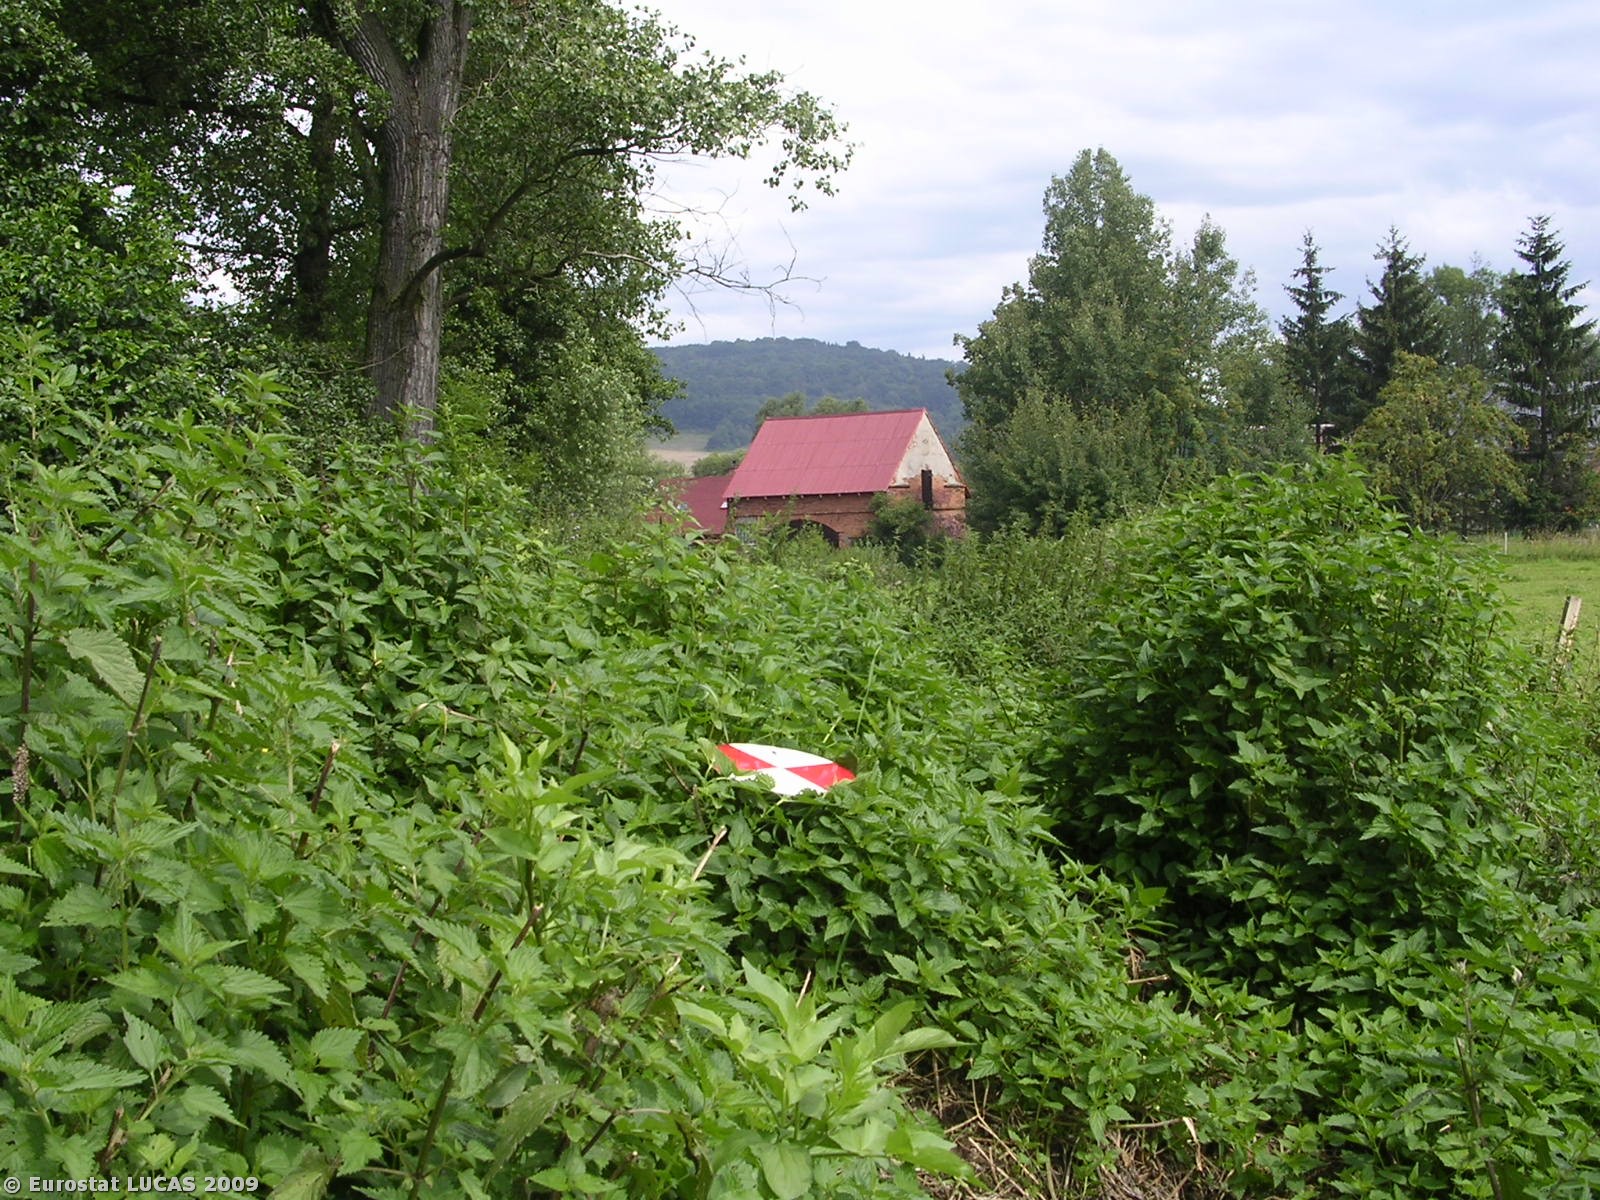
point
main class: Grassland
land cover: Spontaneously vegetated surfaces
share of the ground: > 75 %
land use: Unused
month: July
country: CZ
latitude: 50.6913
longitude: 14.4608
